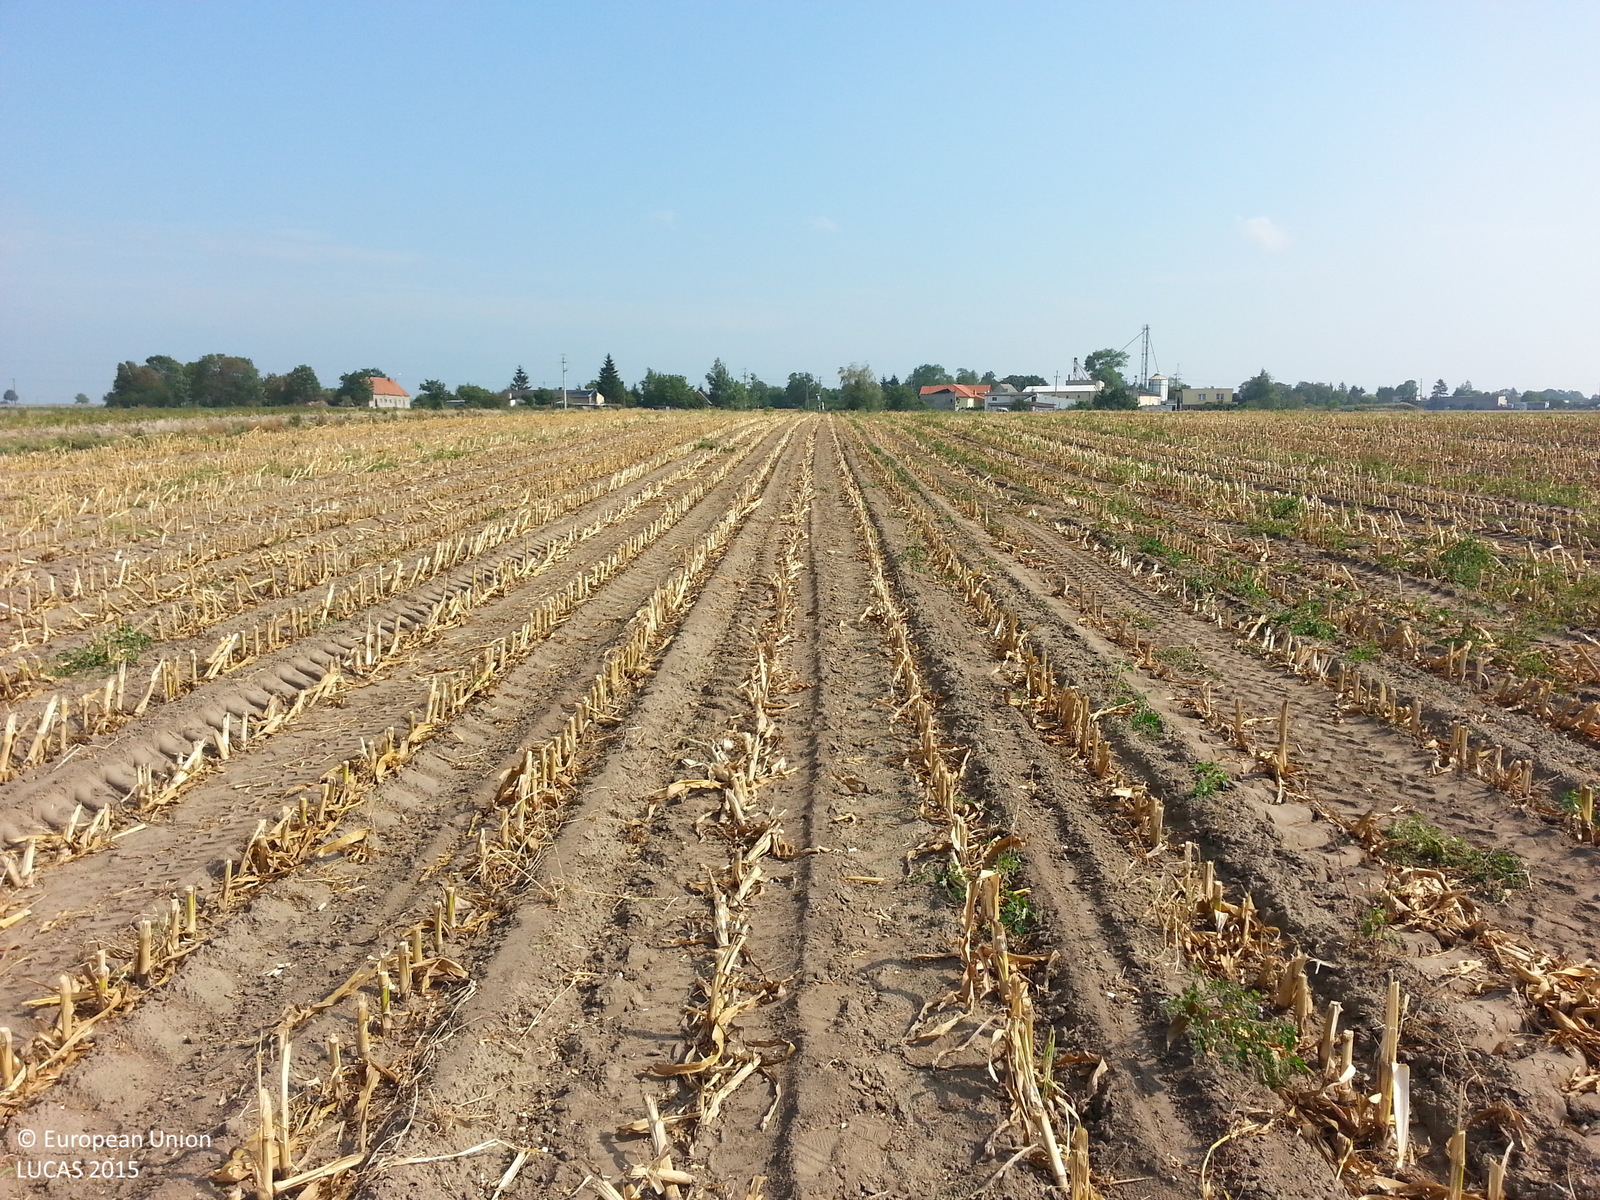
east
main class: Cropland
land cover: Maize
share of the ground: 25 - 50 %
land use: Agriculture (excluding fallow land and kitchen gardens)
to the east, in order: Maize; Grass margins; Common wheat; Fences; Other fresh vegetables
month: September
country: PL
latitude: 52.9320
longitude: 18.0942
